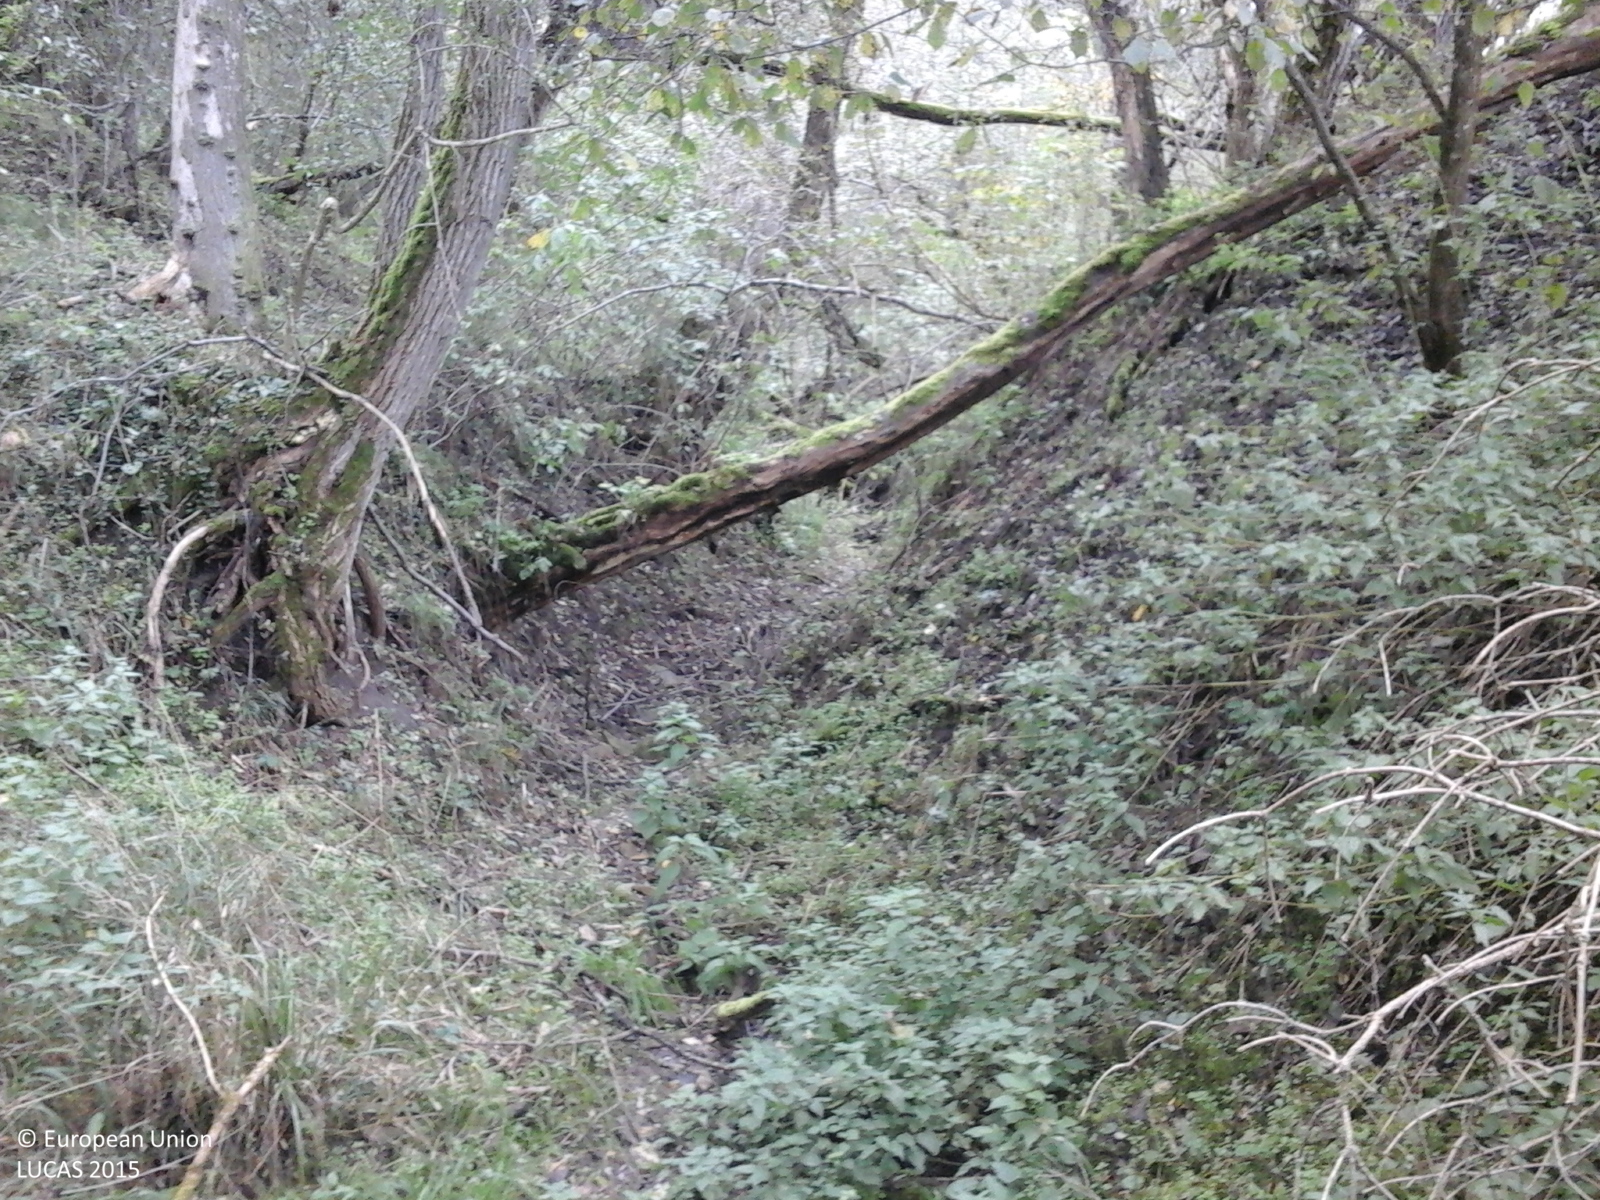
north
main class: Woodland
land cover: Broadleaved woodland
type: exotic forest
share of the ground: > 75 %
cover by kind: broadleaved forest trees 100 %
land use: Forestry
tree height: > 5 m
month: October
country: RO
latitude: 45.9045
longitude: 24.6385
